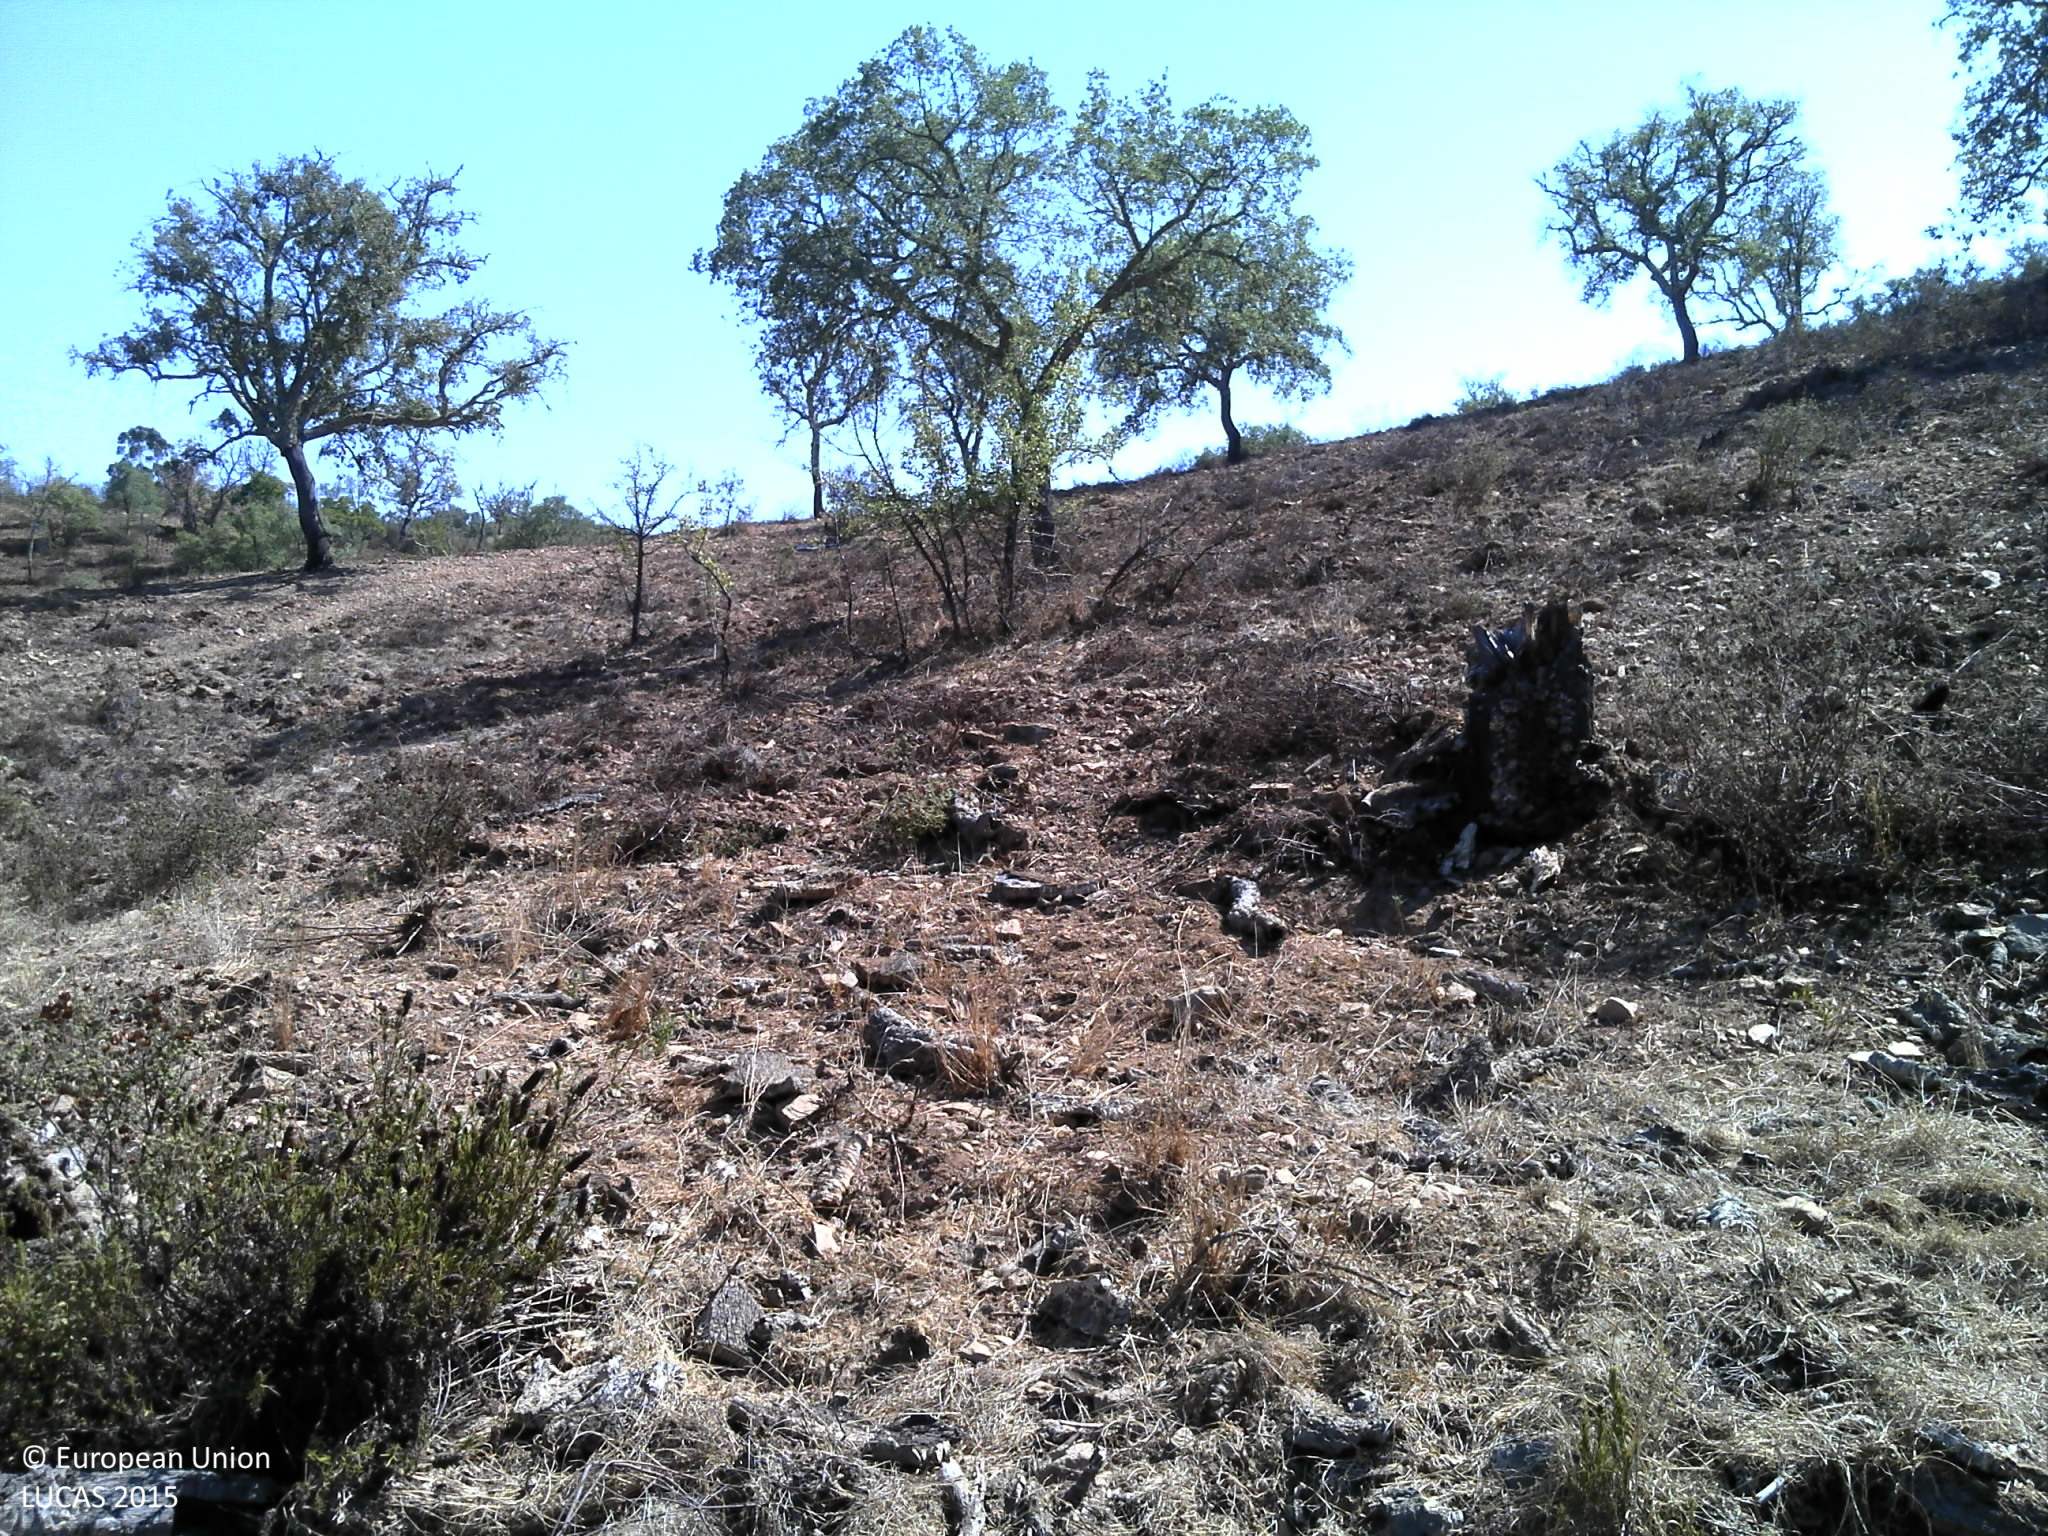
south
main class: Woodland
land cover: Broadleaved woodland
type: broadleaved evergreen forest
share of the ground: 25 - 50 %
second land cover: Grassland without tree/shrub cover
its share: 10 - 25 %
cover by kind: unconsolidated bare surface 45 %, broadleaved forest trees 30 %, herbaceous plants 20 %, shrubs 5 %
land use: Forestry
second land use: Agriculture (excluding fallow land and kitchen gardens)
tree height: > 5 m
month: September
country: PT
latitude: 37.4719
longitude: -8.2184
